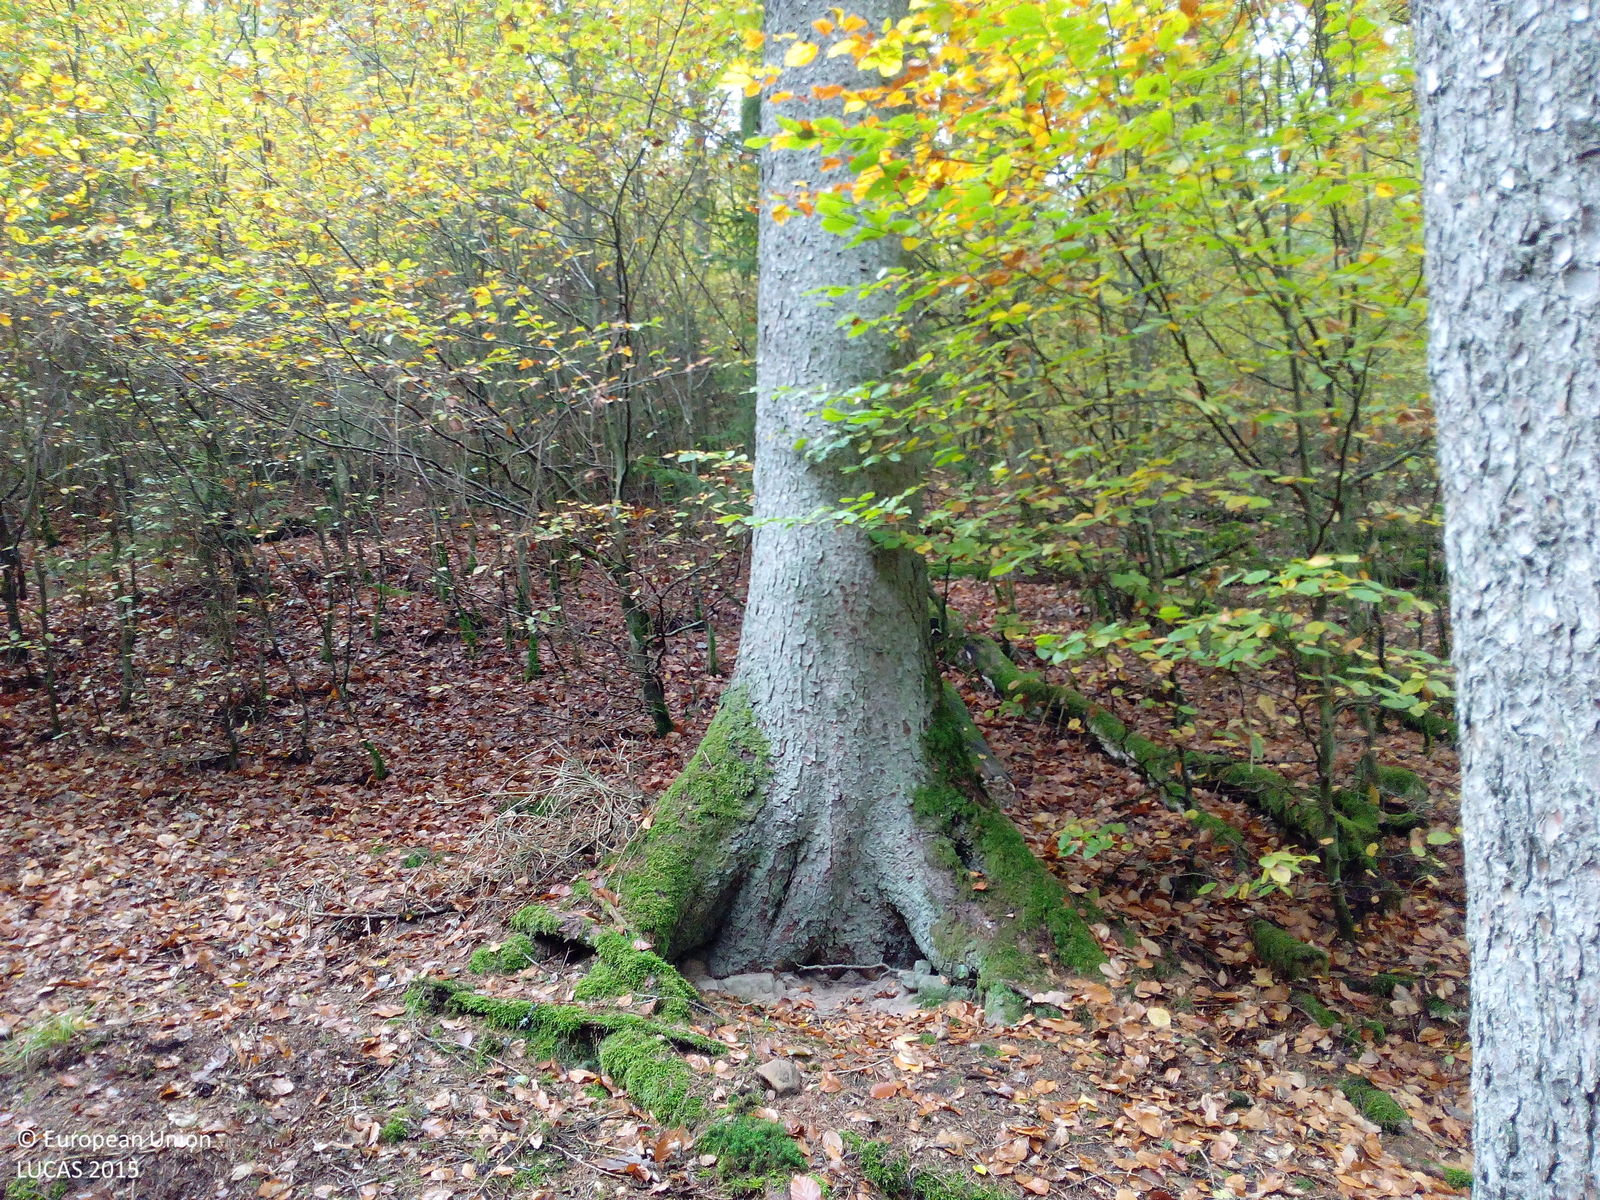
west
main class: Woodland
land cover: Spruce dominated mixed woodland
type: hemiboreal forest and nemoral coniferous forest and mixed broadleaved-coniferous forest
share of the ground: 50 - 75 %
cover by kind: broadleaved forest trees 40 %, coniferous forest trees 25 %, lichens and mosses 15 %, unconsolidated bare surface 10 %, shrubs 5 %, herbaceous plants 5 %
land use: Forestry
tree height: > 5 m
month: October
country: DE
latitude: 50.2554
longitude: 9.5934
